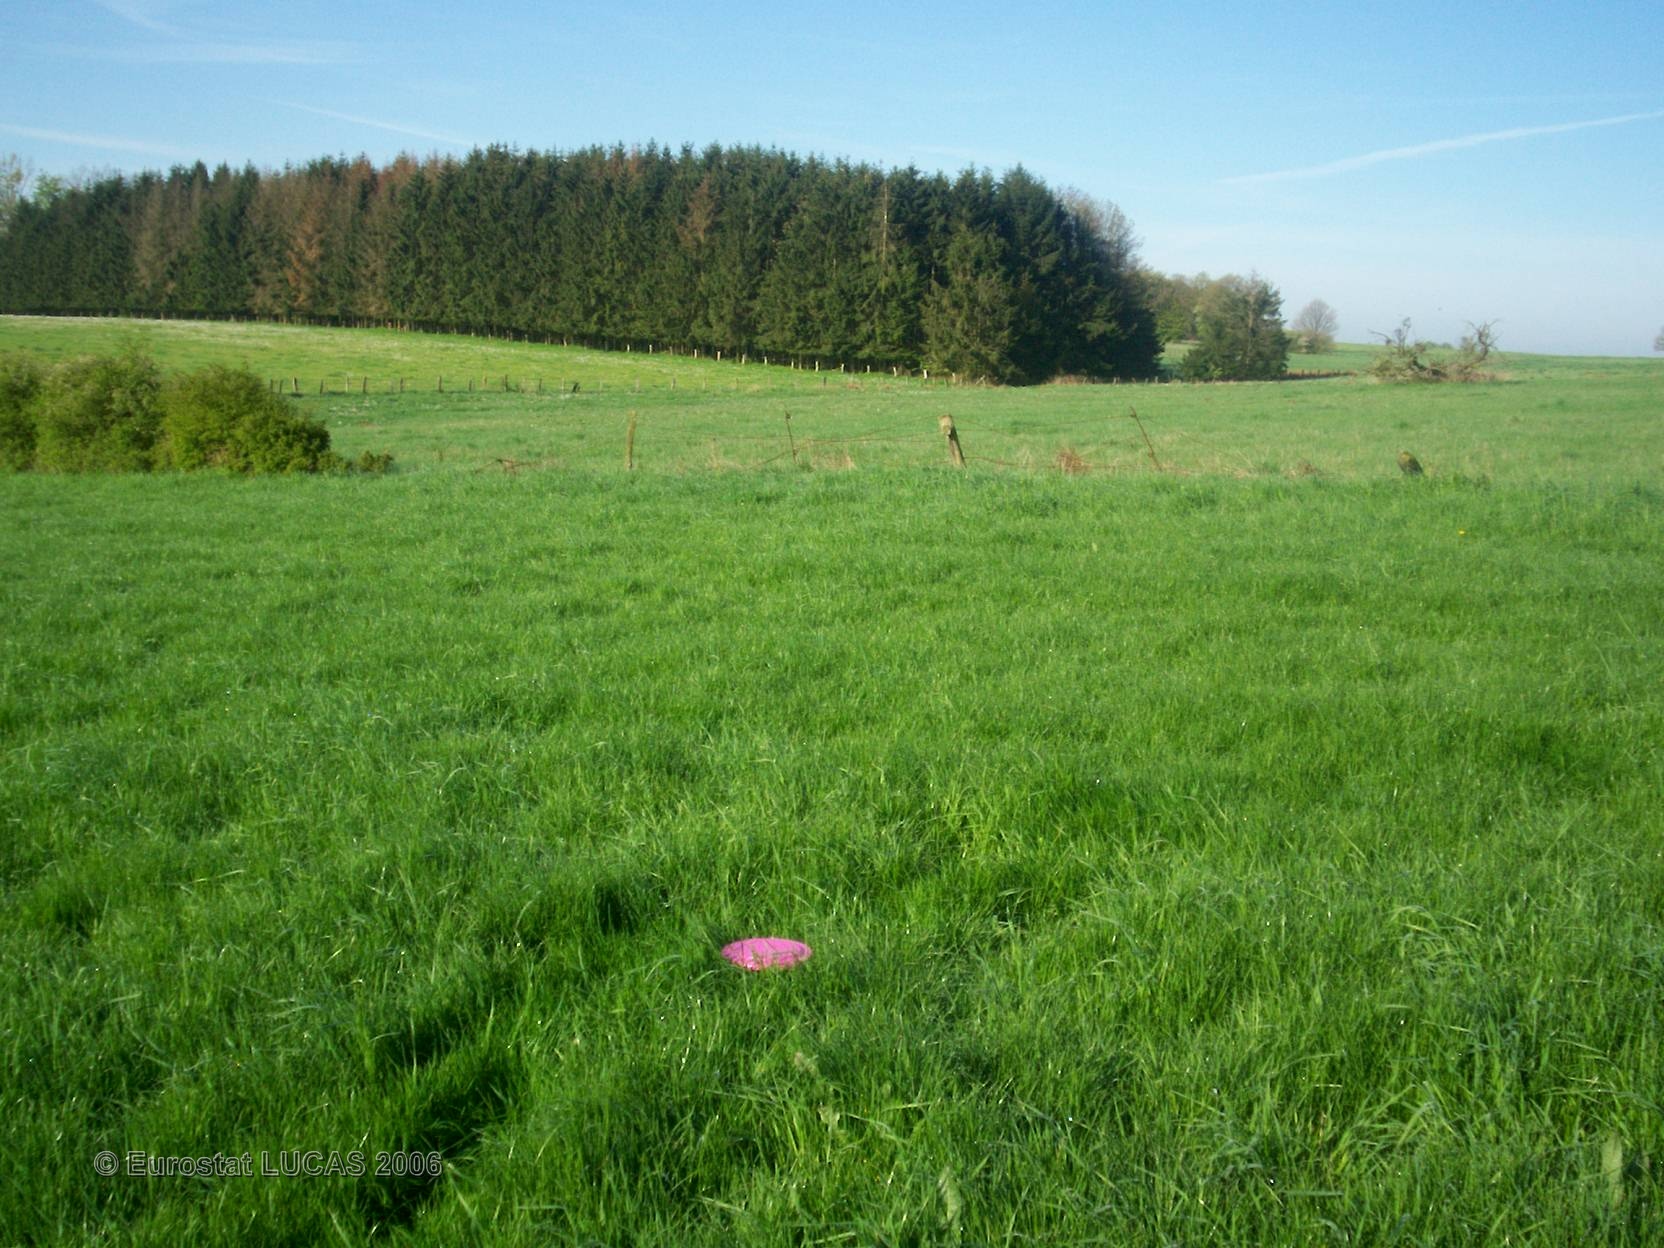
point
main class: Grassland
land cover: Grassland without tree/shrub cover
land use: Agriculture (excluding fallow land and kitchen gardens)
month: May
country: FR
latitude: 49.0987
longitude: 6.9187
